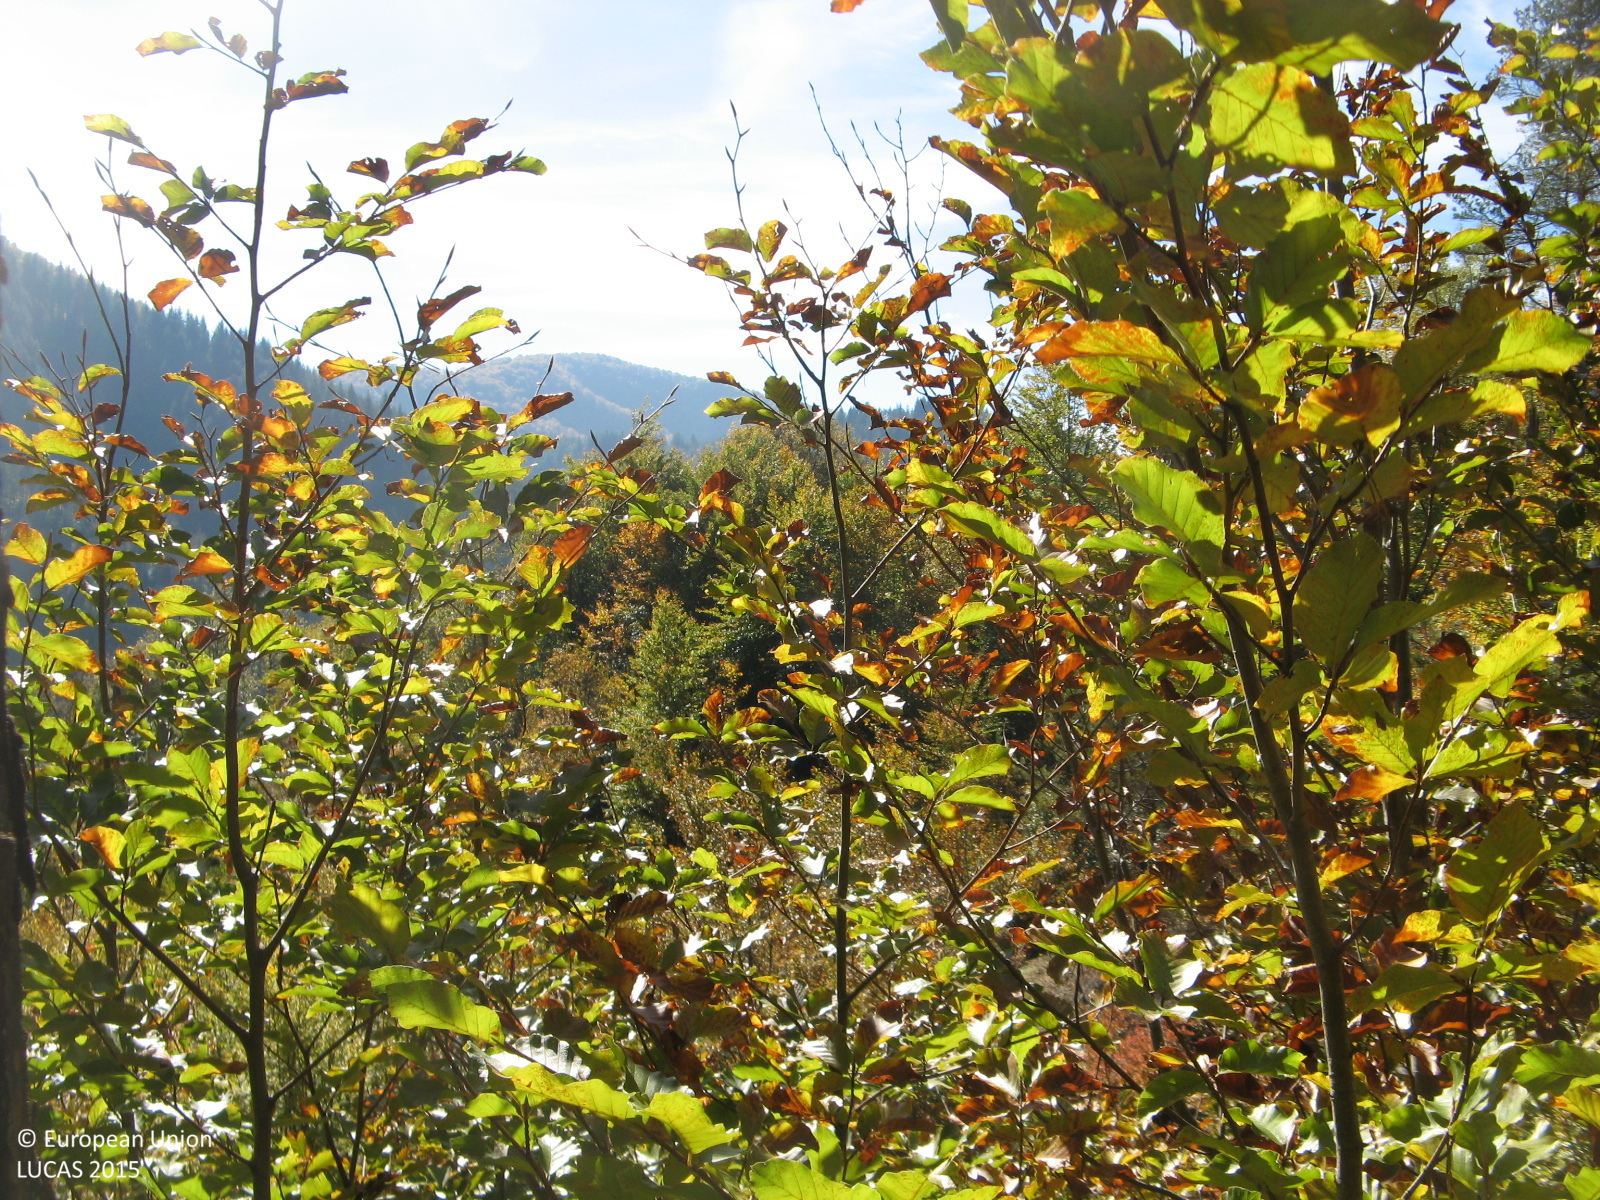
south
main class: Woodland
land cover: Pine dominated mixed woodland
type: hemiboreal forest and nemoral coniferous forest and mixed broadleaved-coniferous forest
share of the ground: > 75 %
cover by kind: coniferous forest trees 50 %, broadleaved forest trees 50 %
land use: Forestry
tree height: > 5 m
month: October
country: BG
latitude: 41.4812
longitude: 24.8353
